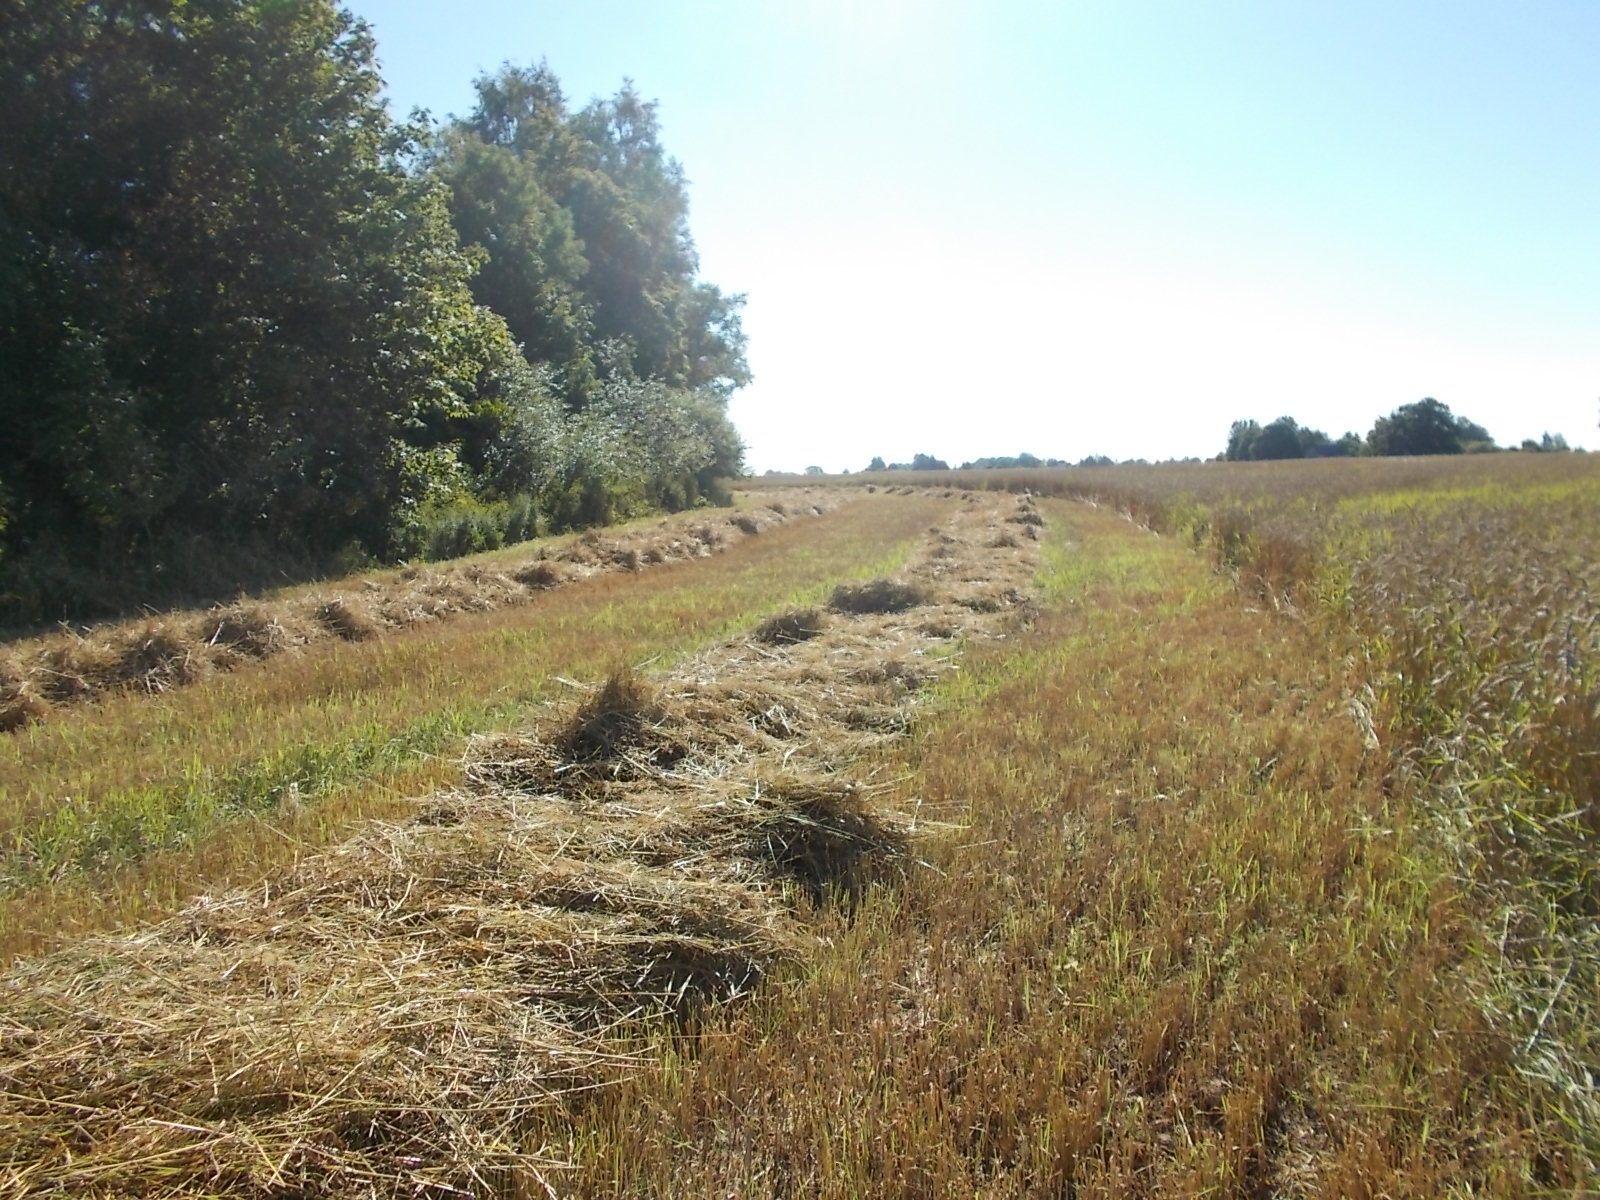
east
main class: Cropland
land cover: Common wheat
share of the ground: > 75 %
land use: Agriculture (excluding fallow land and kitchen gardens)
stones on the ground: < 10 %
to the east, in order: Common wheat
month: August
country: LV
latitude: 56.9056
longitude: 22.8535
